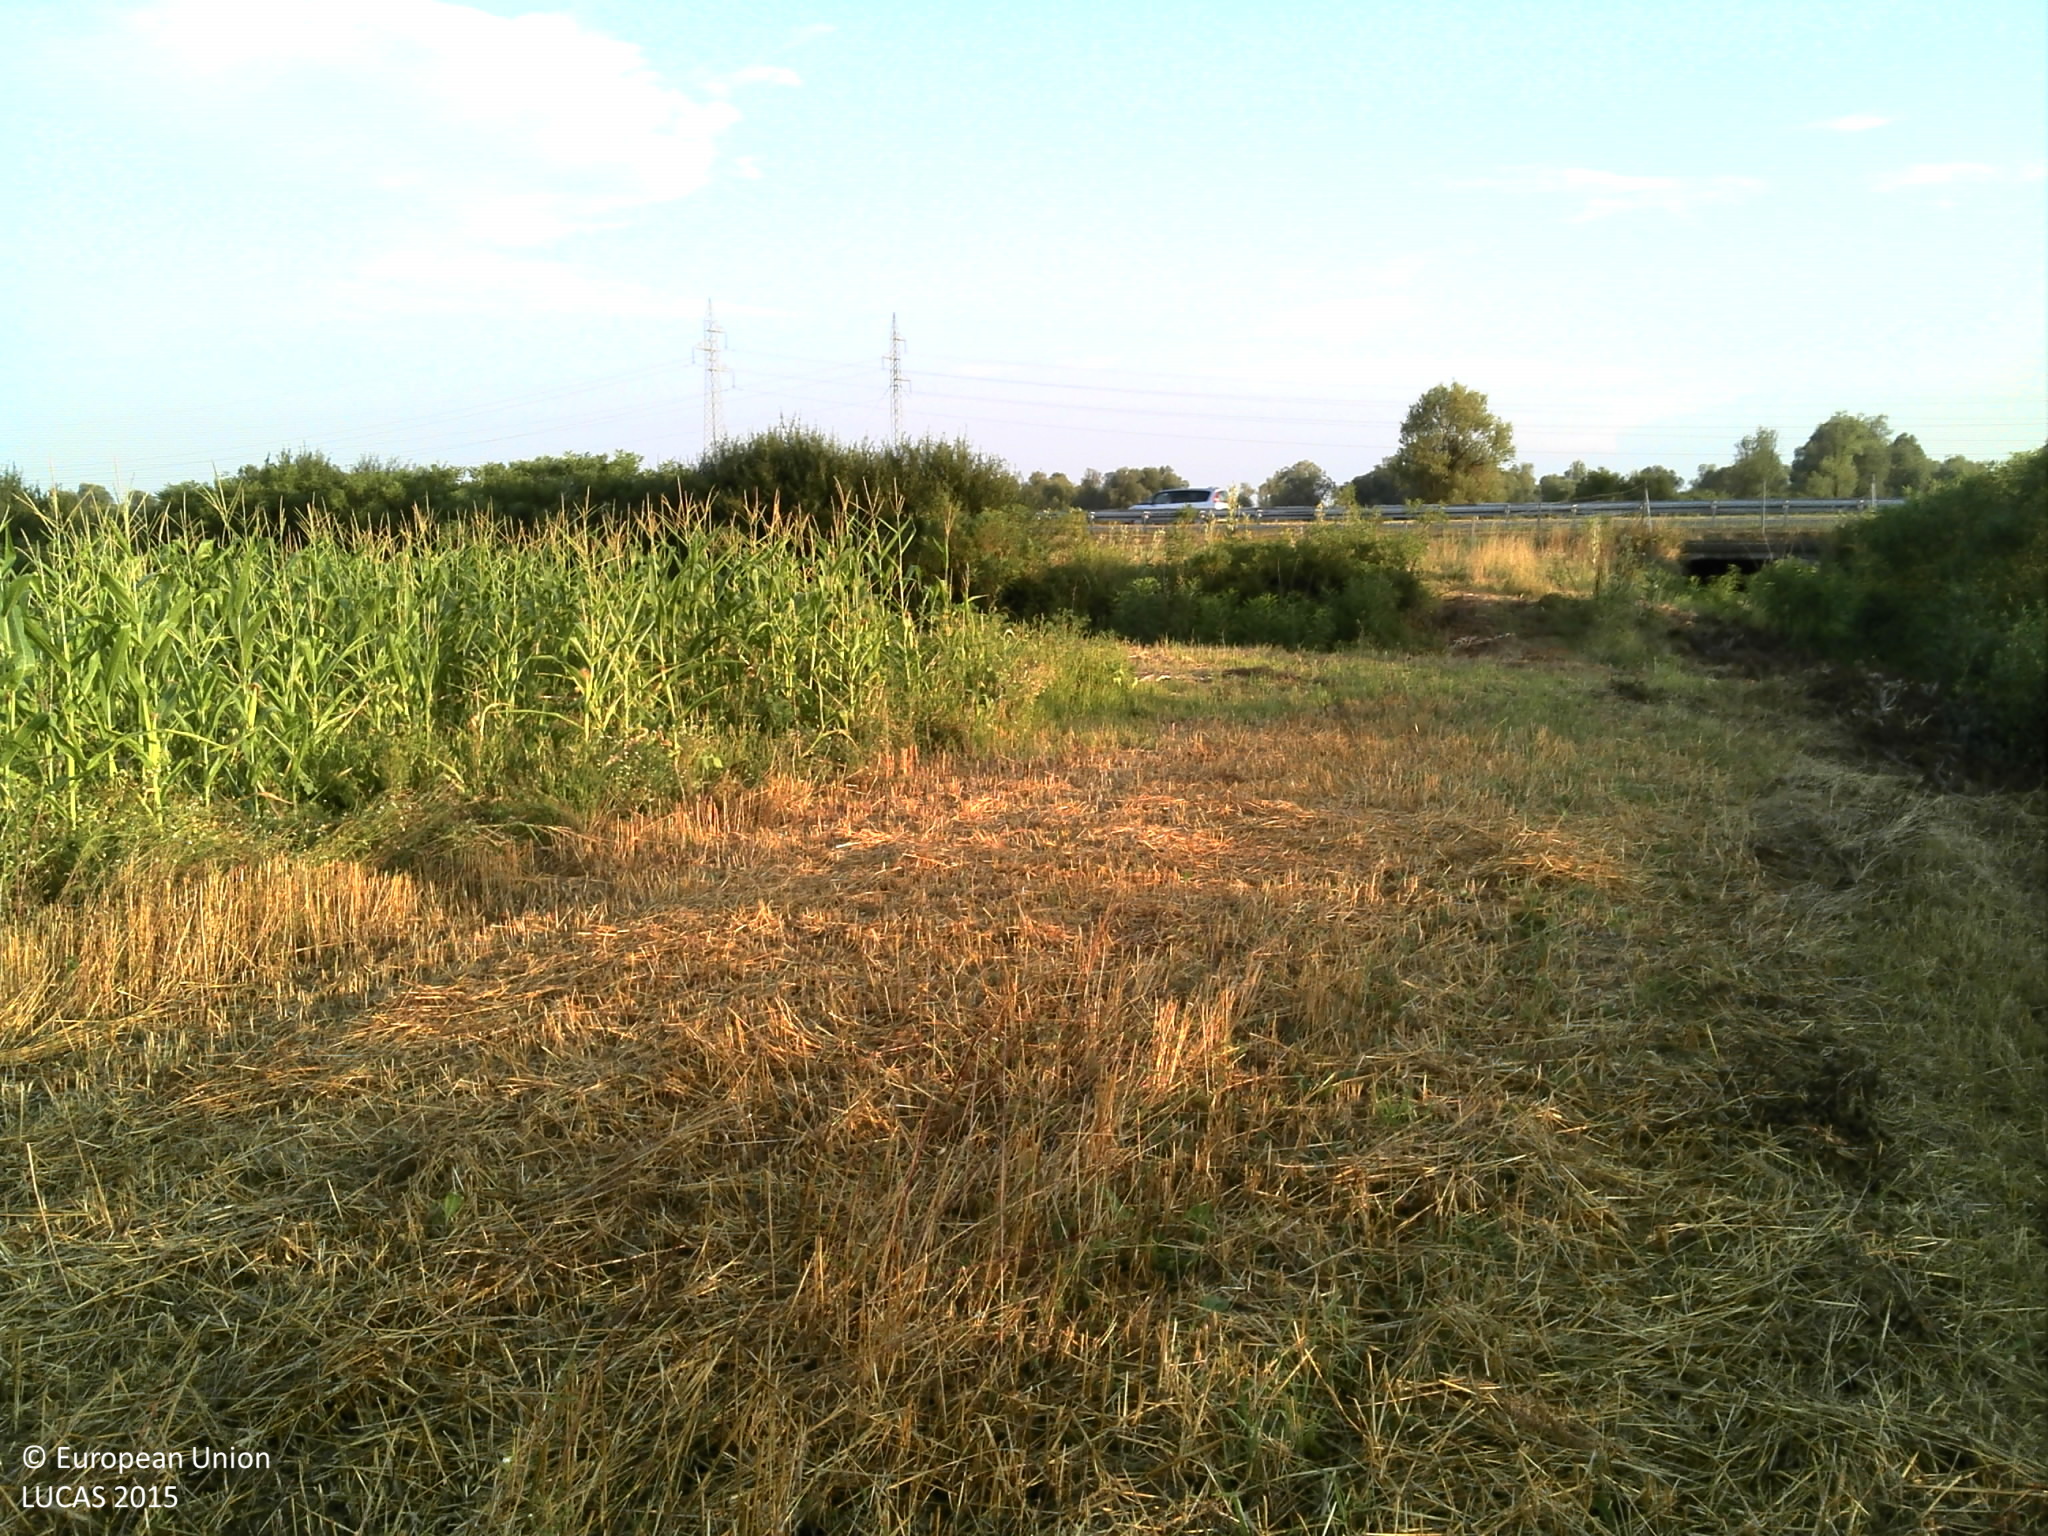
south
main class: Cropland
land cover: Barley
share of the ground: < 10 %
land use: Agriculture (excluding fallow land and kitchen gardens)
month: July
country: HR
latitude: 45.4909
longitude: 16.6908
